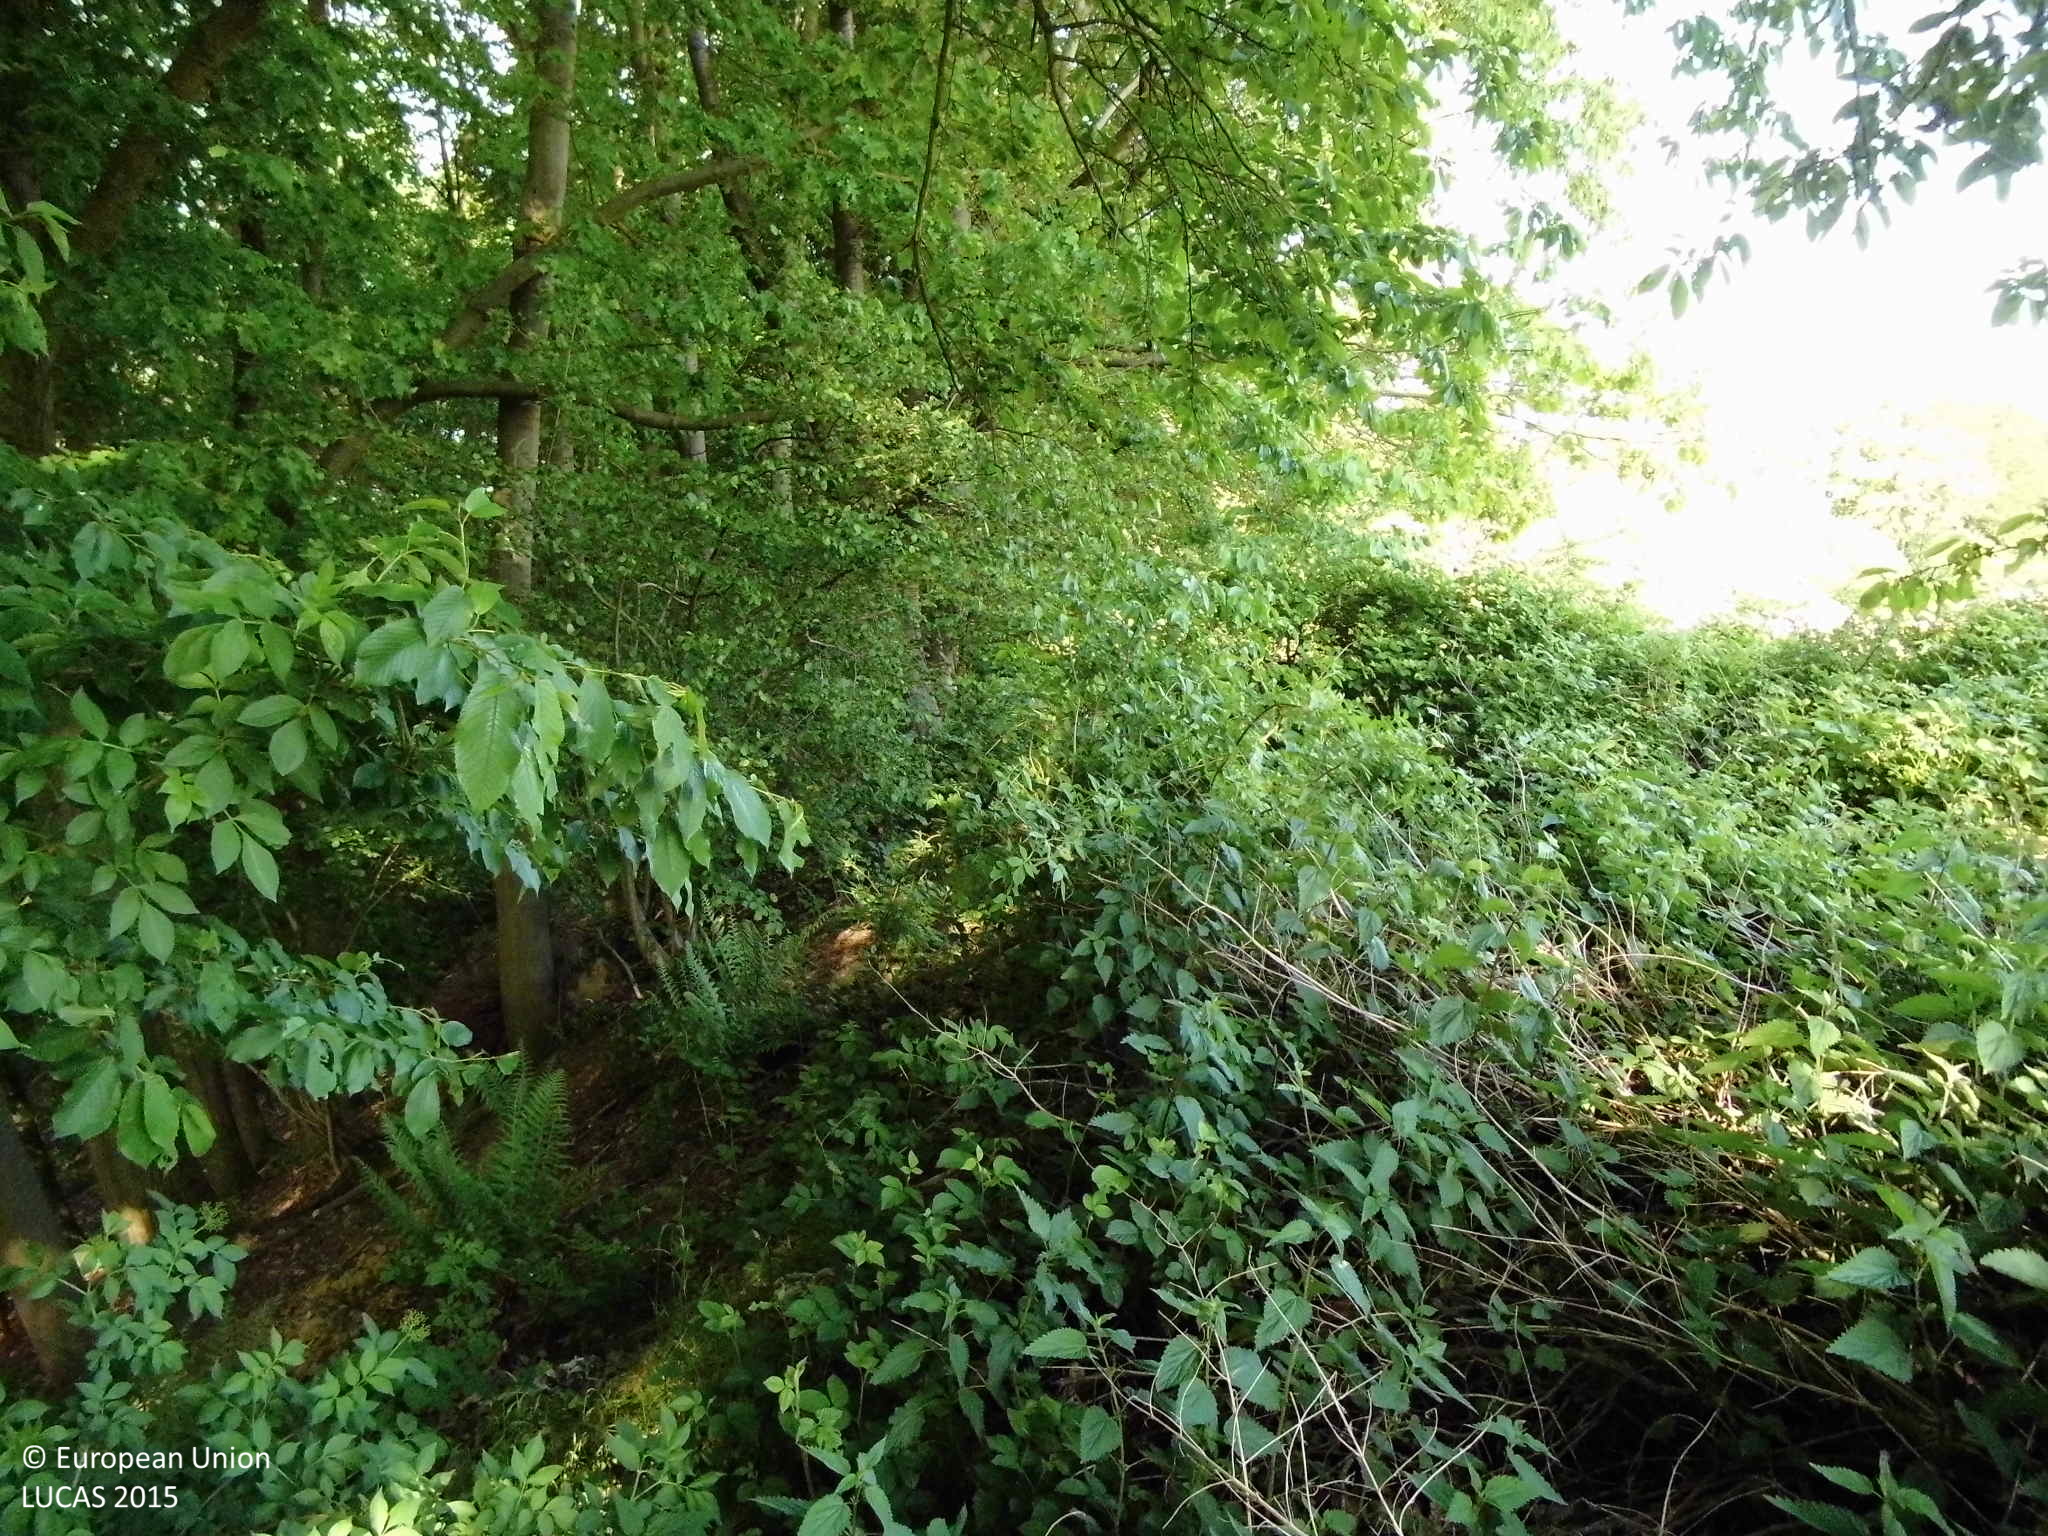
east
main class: Woodland
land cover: Broadleaved woodland
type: mesophytic deciduous forest
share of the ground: > 75 %
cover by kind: broadleaved forest trees 75 %, coniferous forest trees 10 %, shrubs 5 %, herbaceous plants 5 %, unconsolidated bare surface 5 %
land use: Forestry
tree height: > 5 m
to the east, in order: Broadleaved woodland; Spruce dominated mixed woodland; Broadleaved woodland; Grass margins; Paved roads, cycling and walking lanes
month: May
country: DE
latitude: 50.7689
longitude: 7.5189
